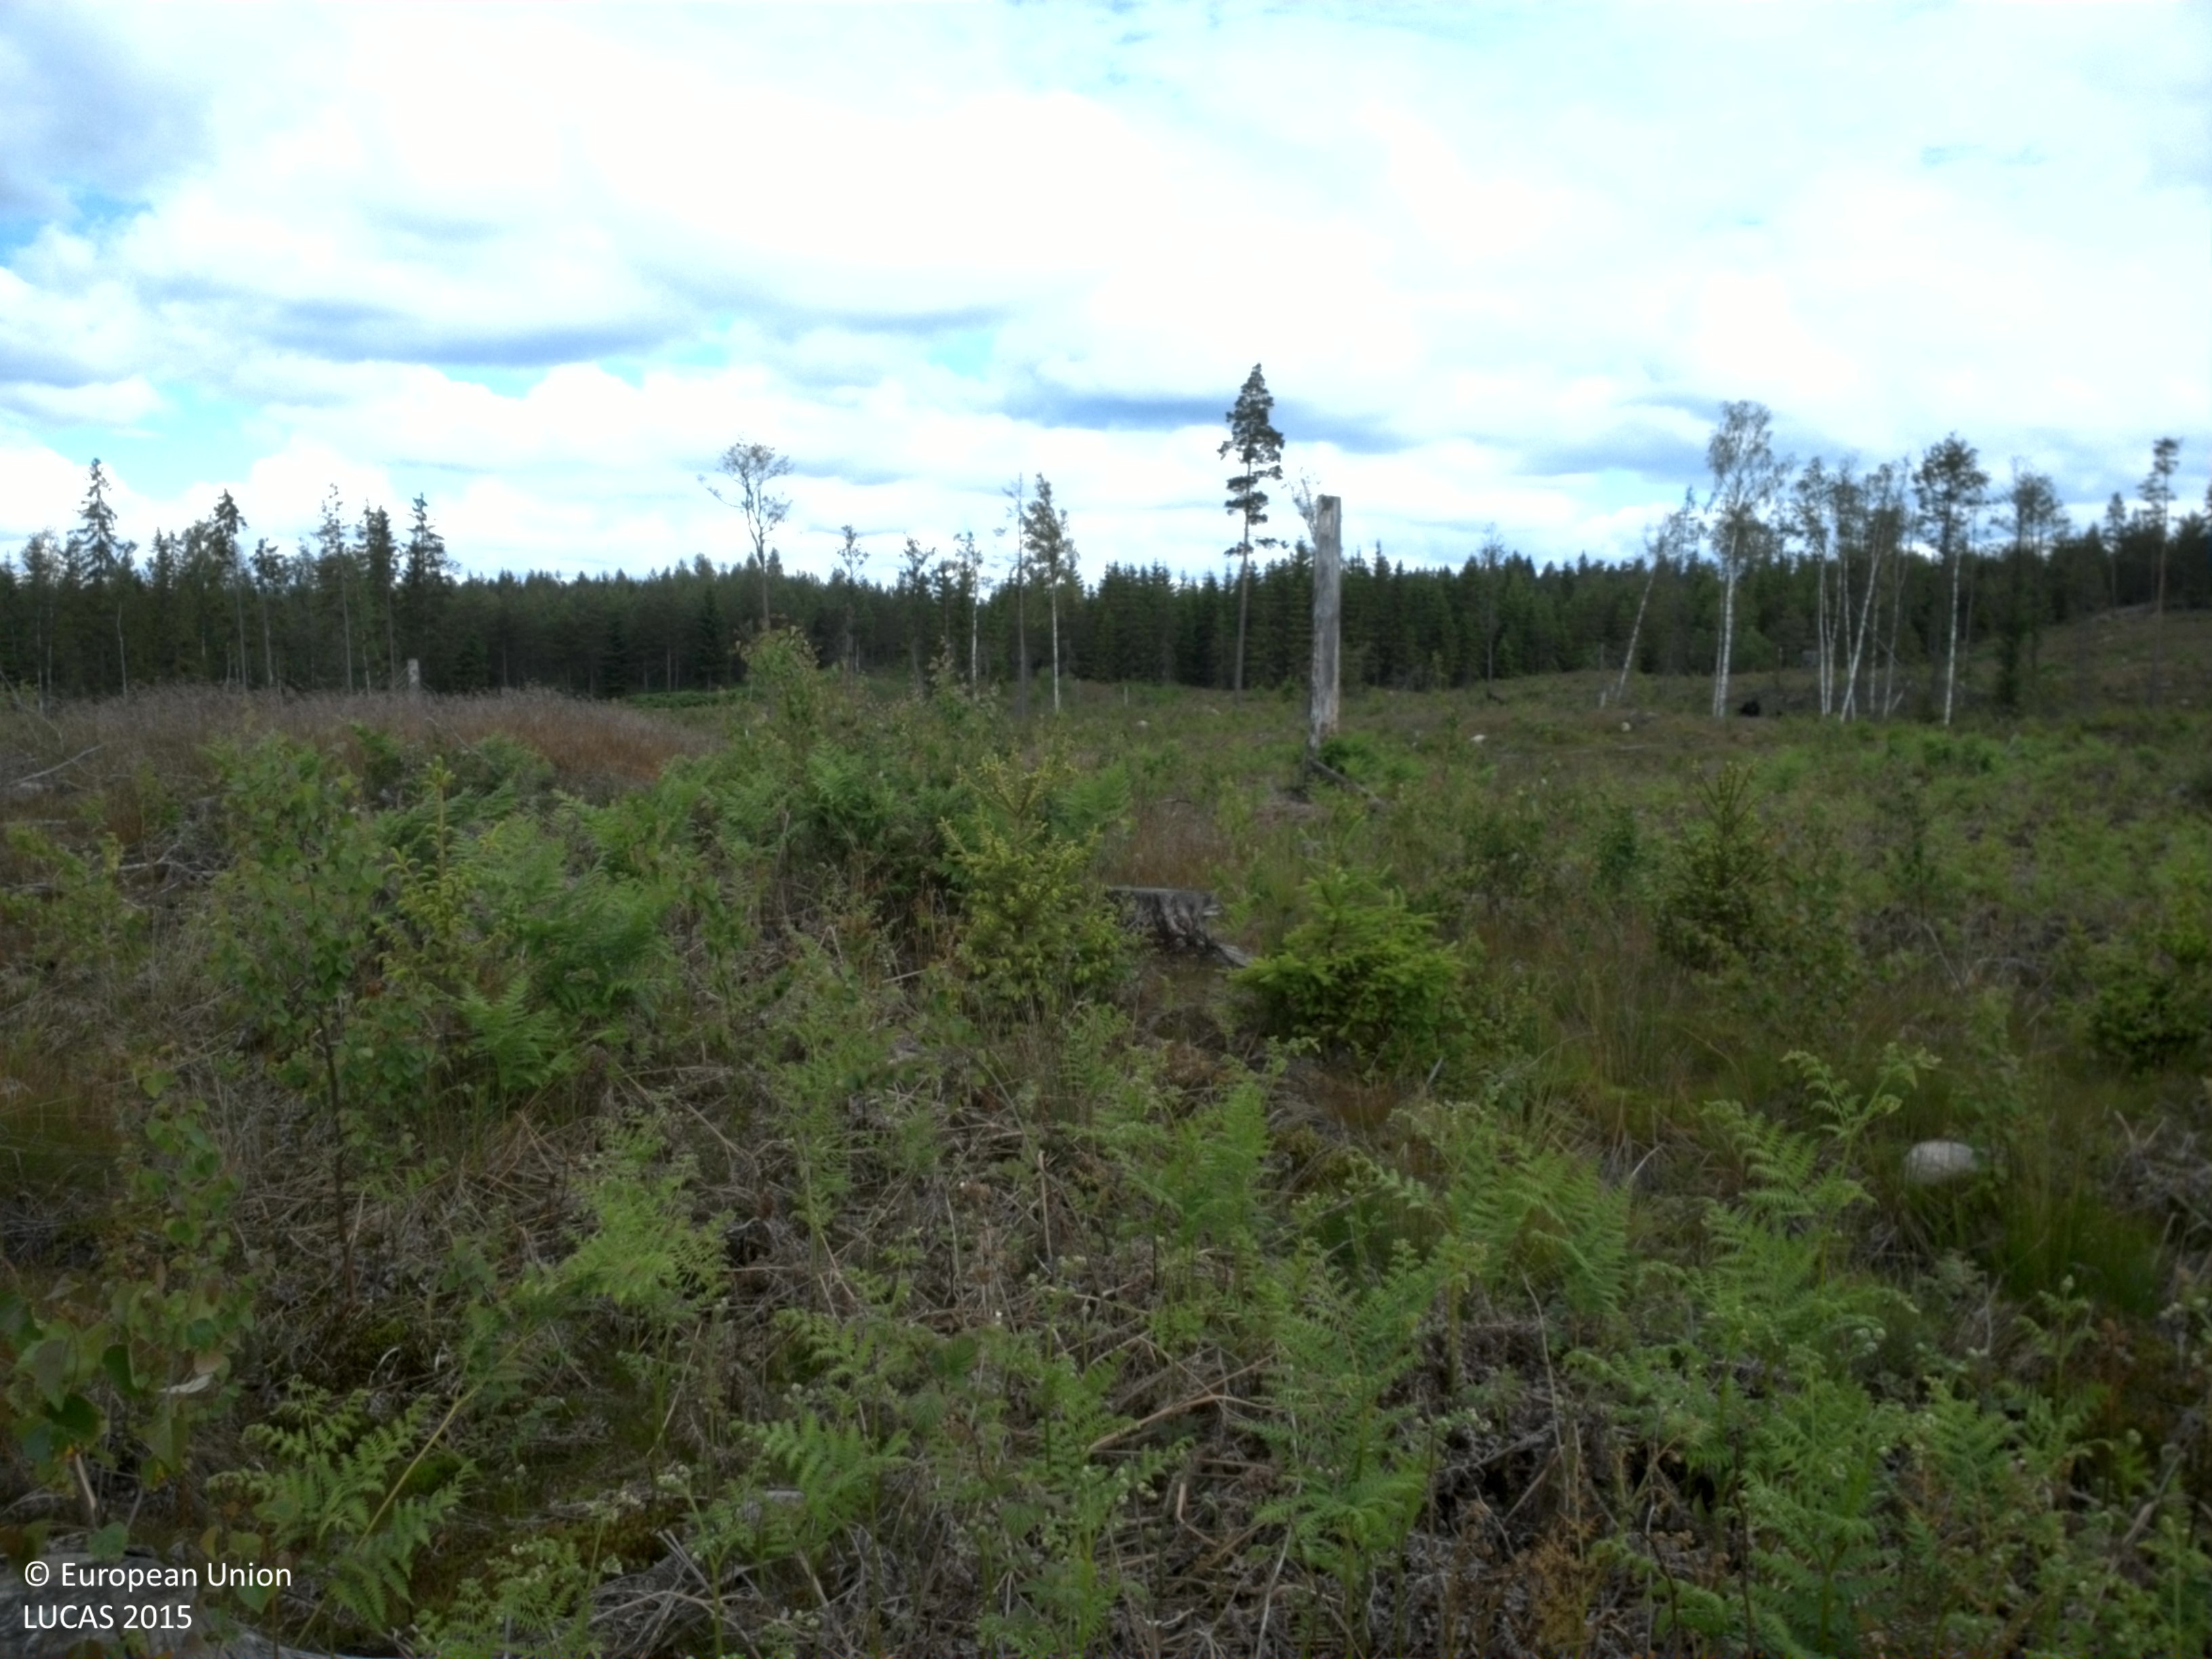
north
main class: Woodland
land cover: Spruce dominated mixed woodland
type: boreal forest
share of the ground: 50 - 75 %
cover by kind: coniferous forest trees 35 %, herbaceous plants 30 %, broadleaved forest trees 25 %, lichens and mosses 10 %
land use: Forestry
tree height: < 5 m
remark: Clear cut
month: June
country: SE
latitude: 58.6484
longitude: 15.4907
